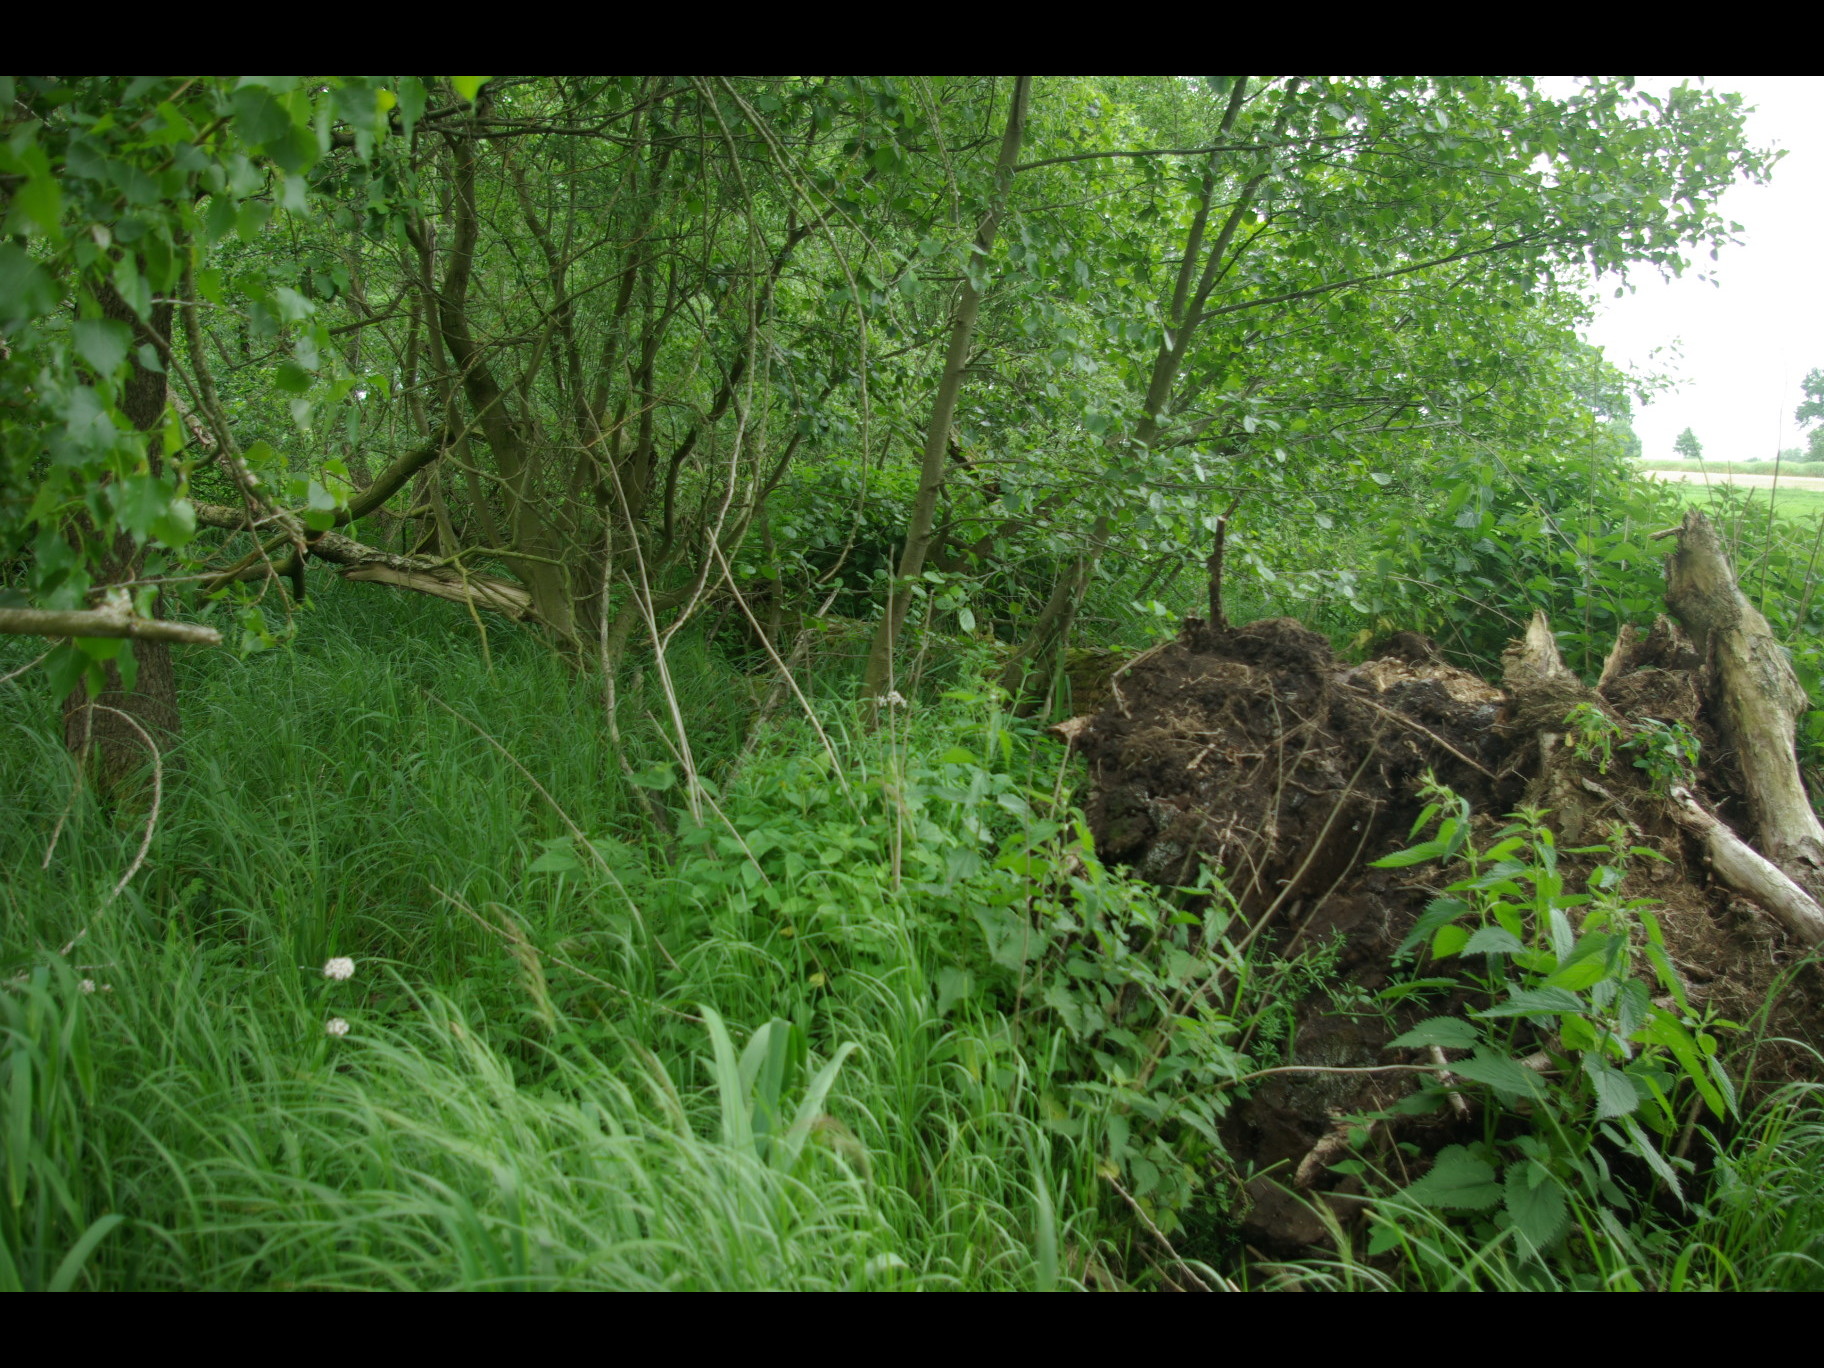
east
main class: Woodland
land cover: Broadleaved woodland
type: mire and swamp forests
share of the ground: 50 - 75 %
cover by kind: broadleaved forest trees 50 %, herbaceous plants 45 %, shrubs 5 %
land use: Semi-natural and natural areas not in use
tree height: > 5 m
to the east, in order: Broadleaved woodland; Grassland without tree/shrub cover; Tracks; Grassland without tree/shrub cover; Ditches and canals; Grassland without tree/shrub cover
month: June
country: DE
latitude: 54.4263
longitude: 9.9230
